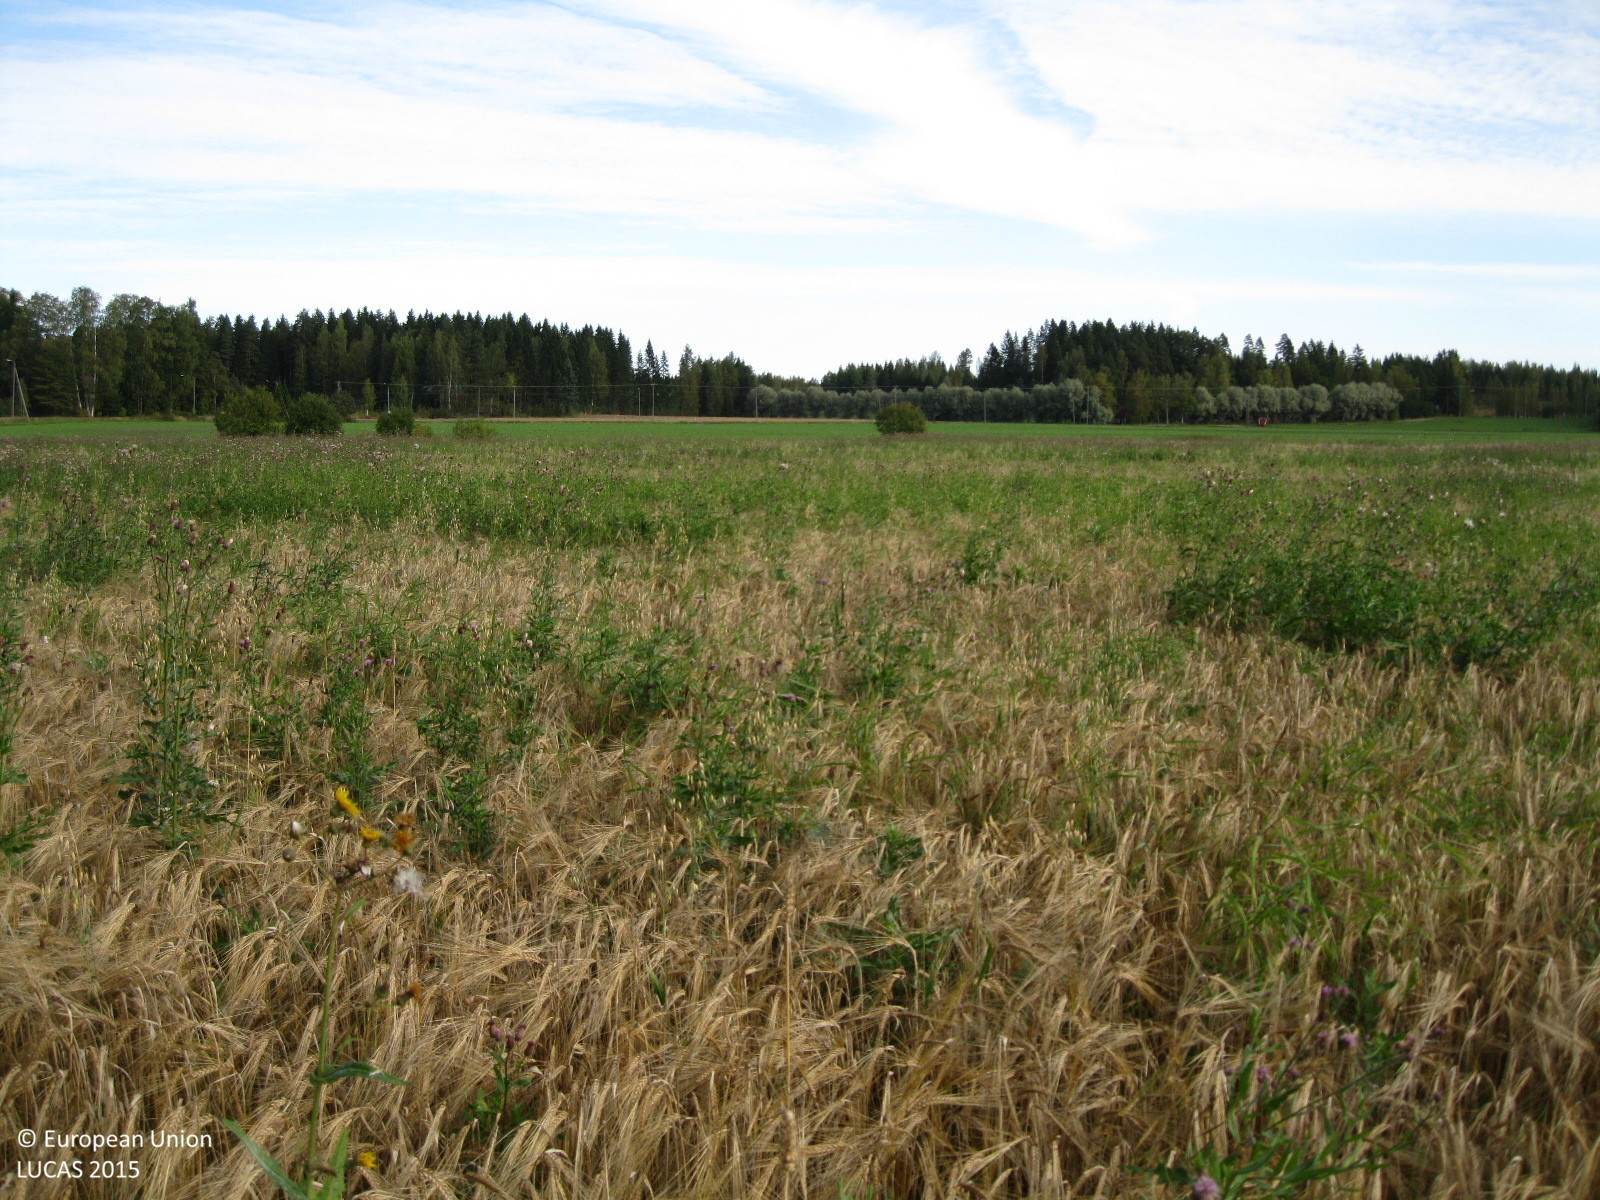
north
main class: Cropland
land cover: Barley
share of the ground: > 75 %
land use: Agriculture (excluding fallow land and kitchen gardens)
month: September
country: FI
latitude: 60.5931
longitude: 24.9221
